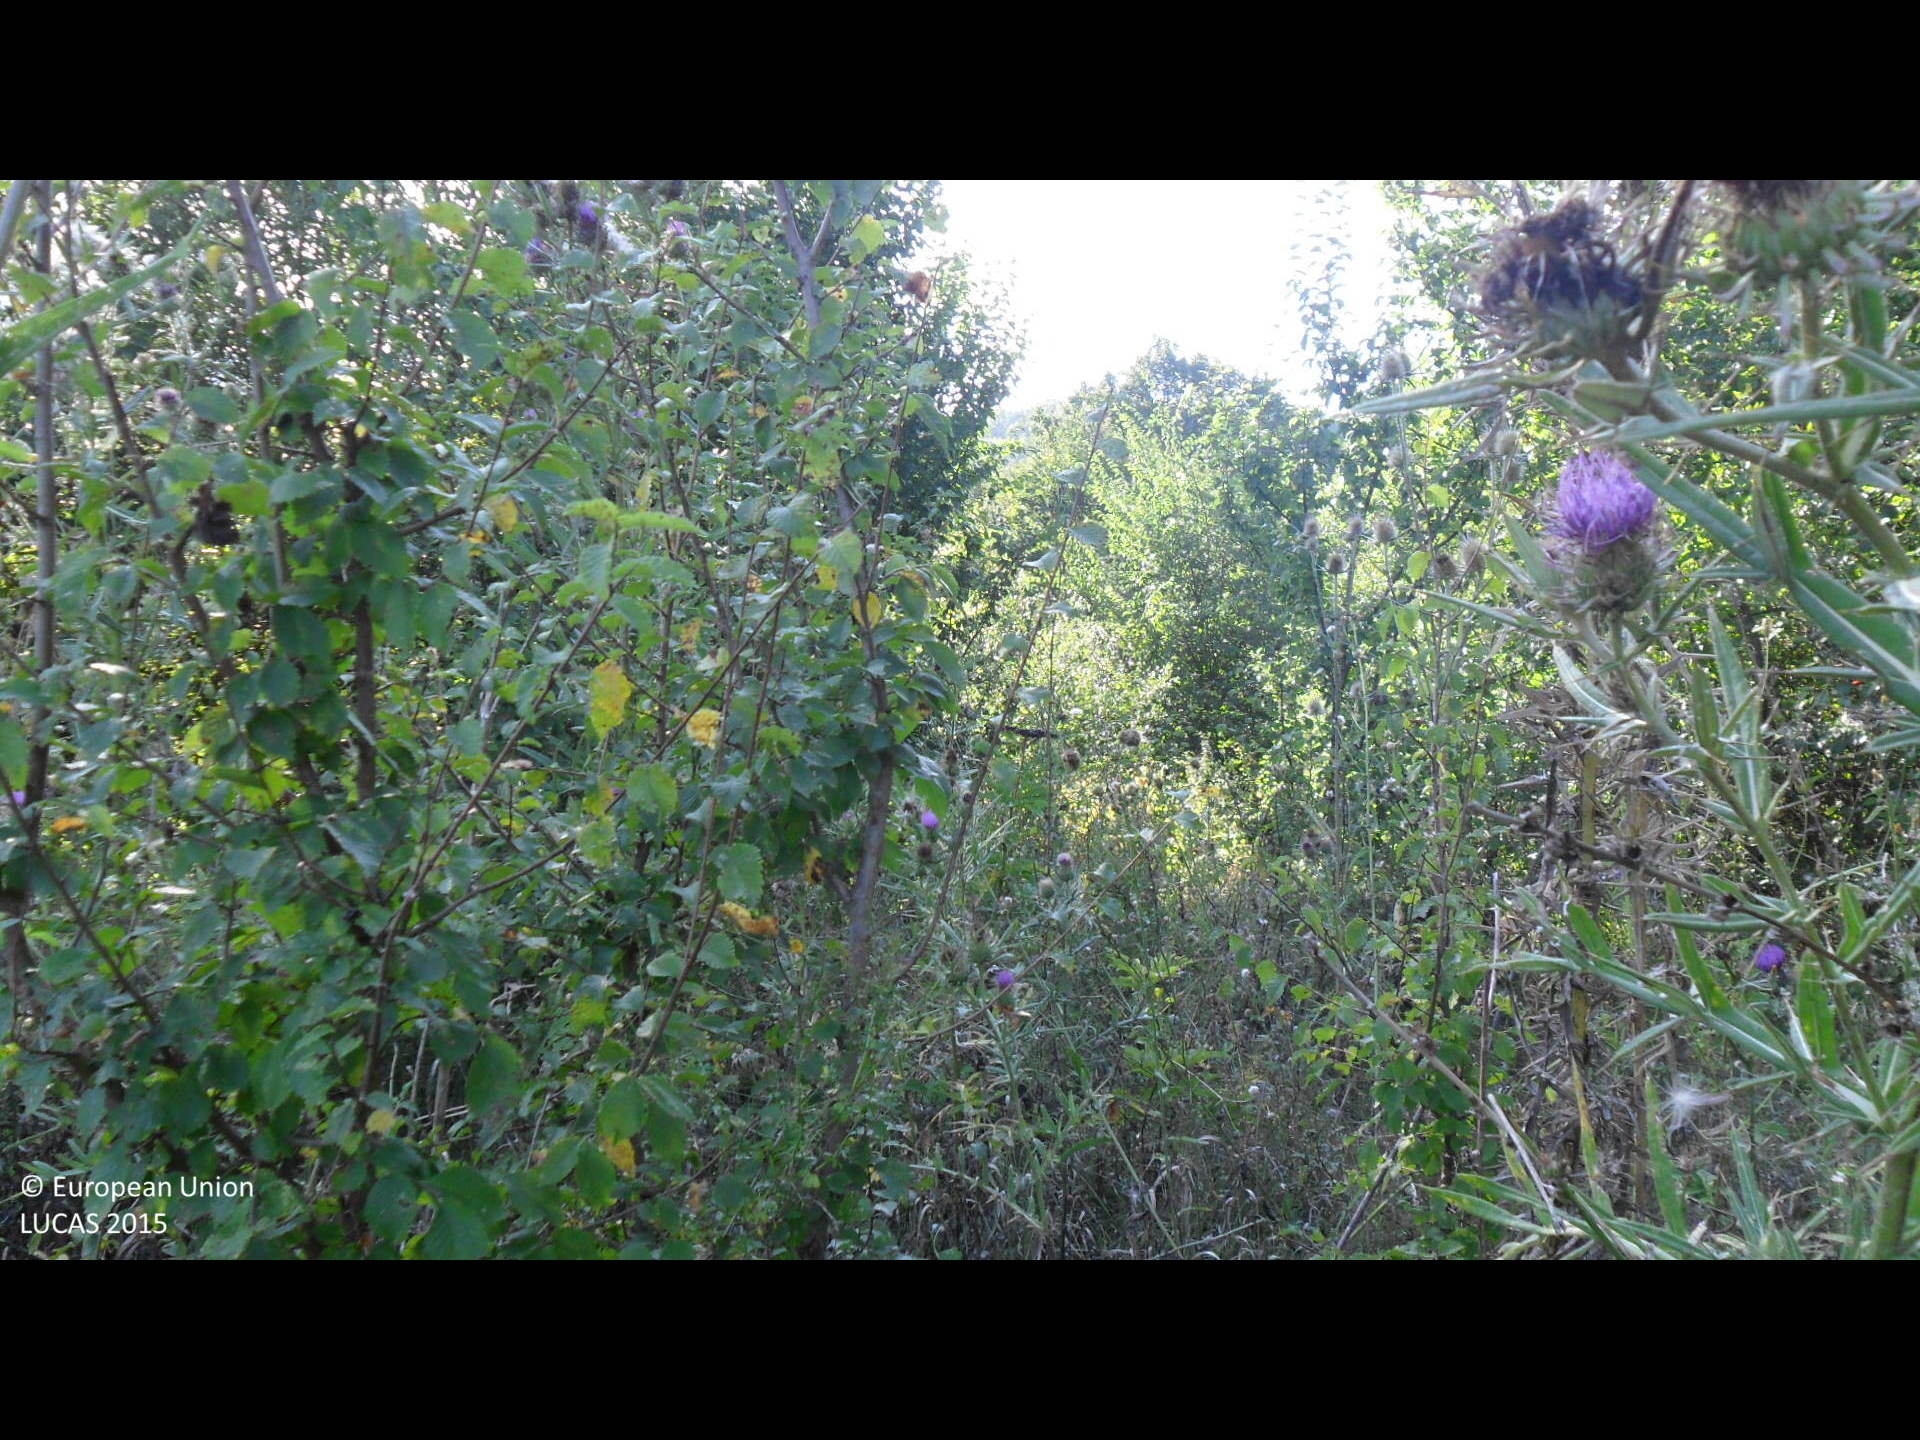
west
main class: Woodland
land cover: Broadleaved woodland
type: mesophytic deciduous forest
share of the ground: > 75 %
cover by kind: broadleaved forest trees 100 %
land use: Forestry
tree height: > 5 m
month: August
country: BG
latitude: 43.1816
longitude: 26.6269
